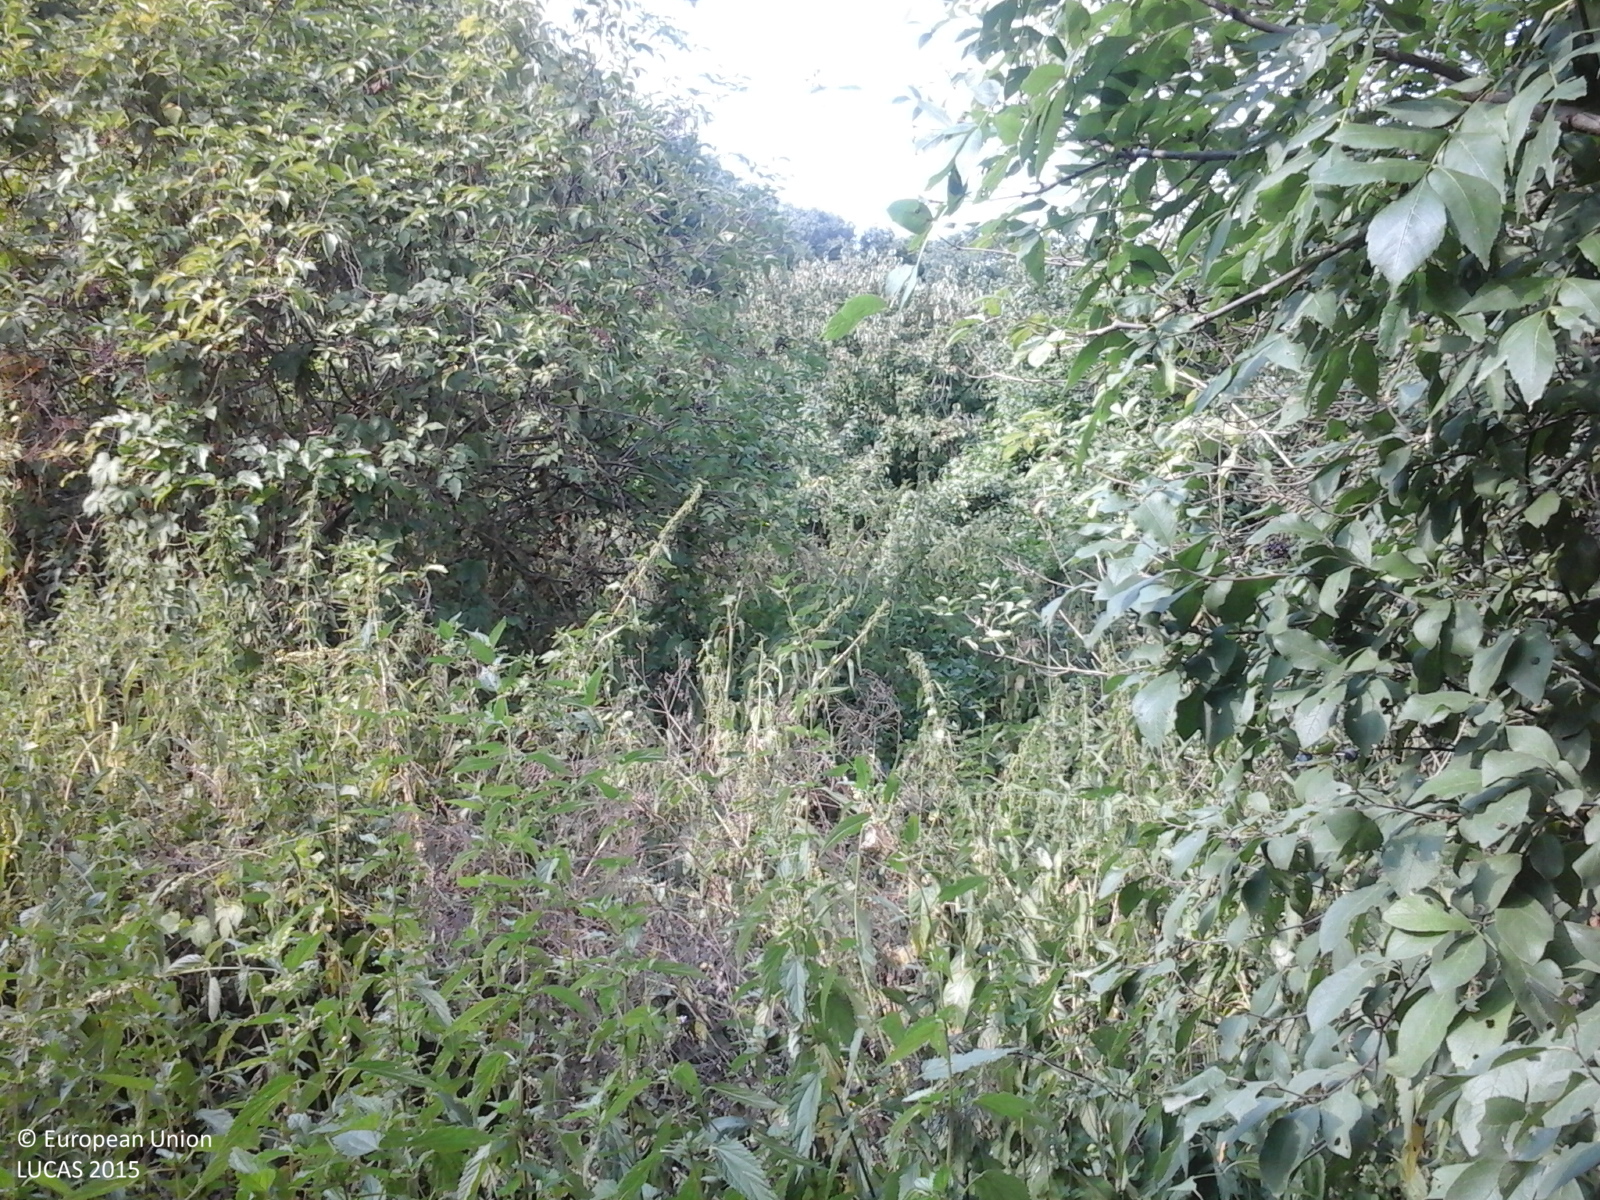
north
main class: Woodland
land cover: Broadleaved woodland
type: exotic forest
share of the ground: > 75 %
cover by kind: broadleaved forest trees 100 %
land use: Forestry
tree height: > 5 m
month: August
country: RO
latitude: 44.0012
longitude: 27.9723
